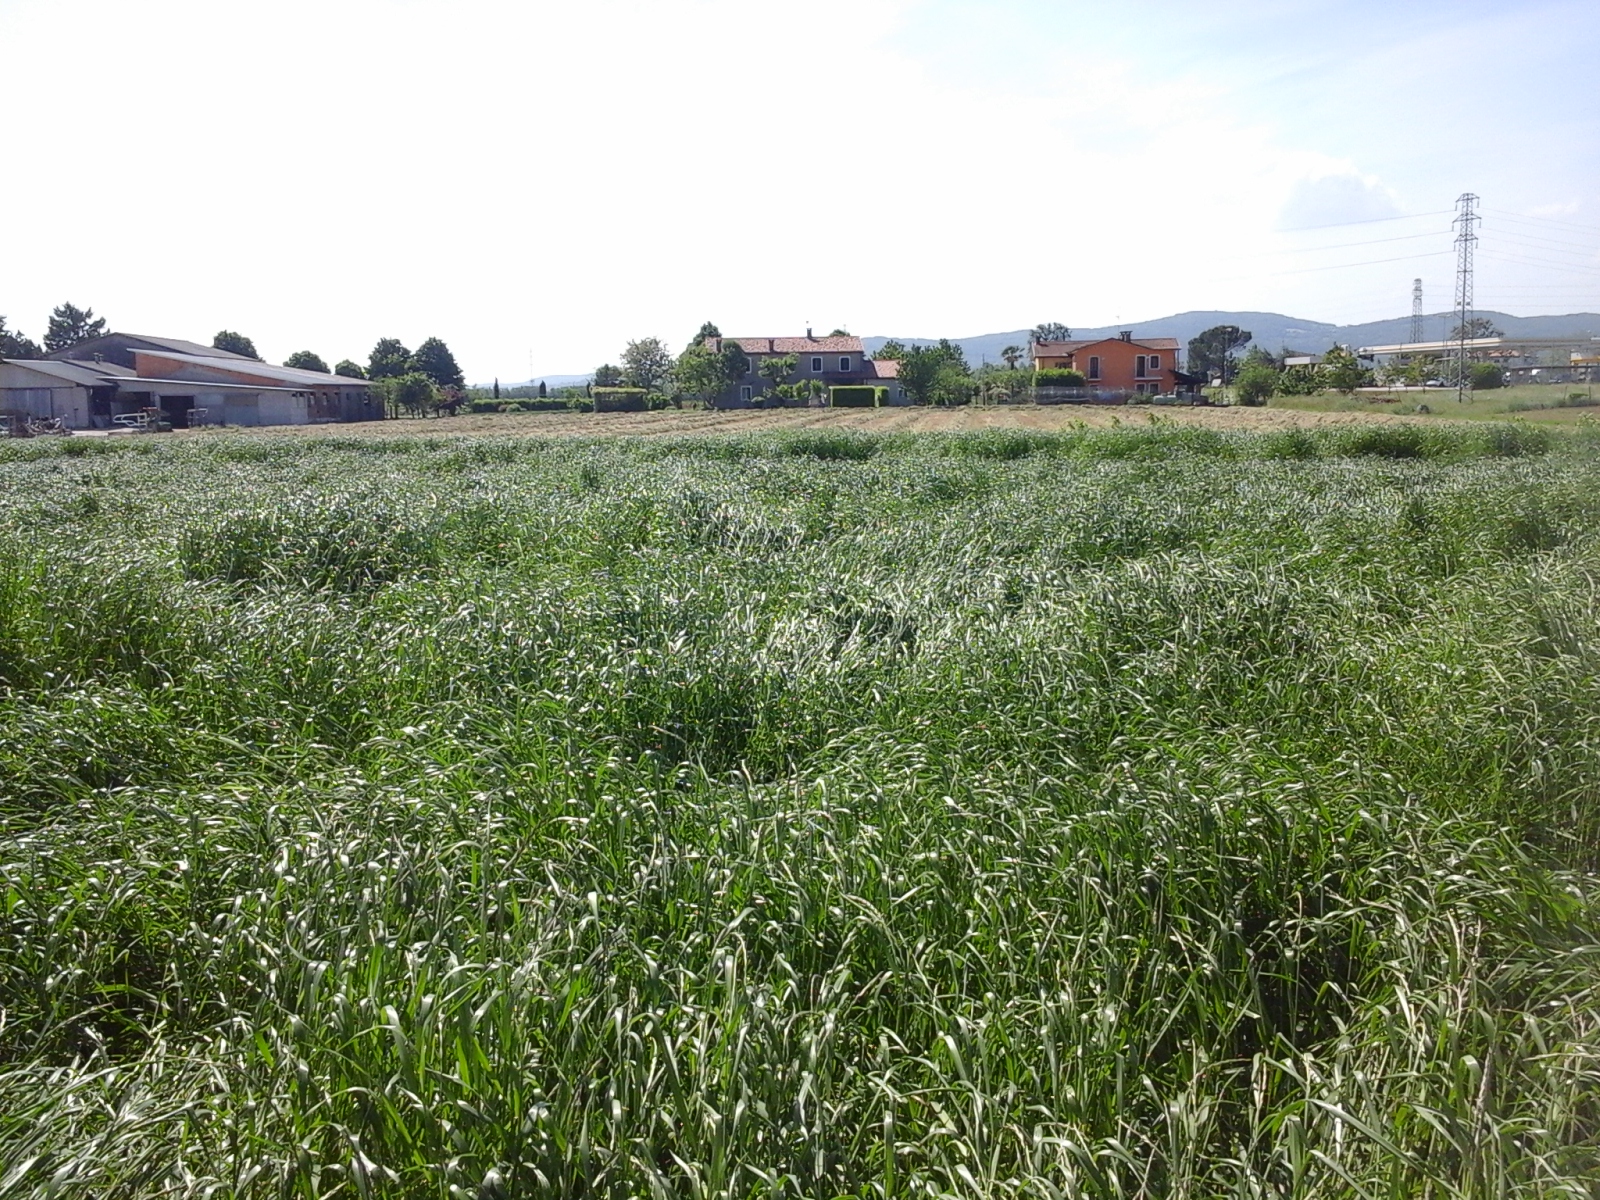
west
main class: Cropland
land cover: Temporary grasslands
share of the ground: > 75 %
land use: Agriculture (excluding fallow land and kitchen gardens)
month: May
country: IT
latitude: 45.3666
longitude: 11.5677
